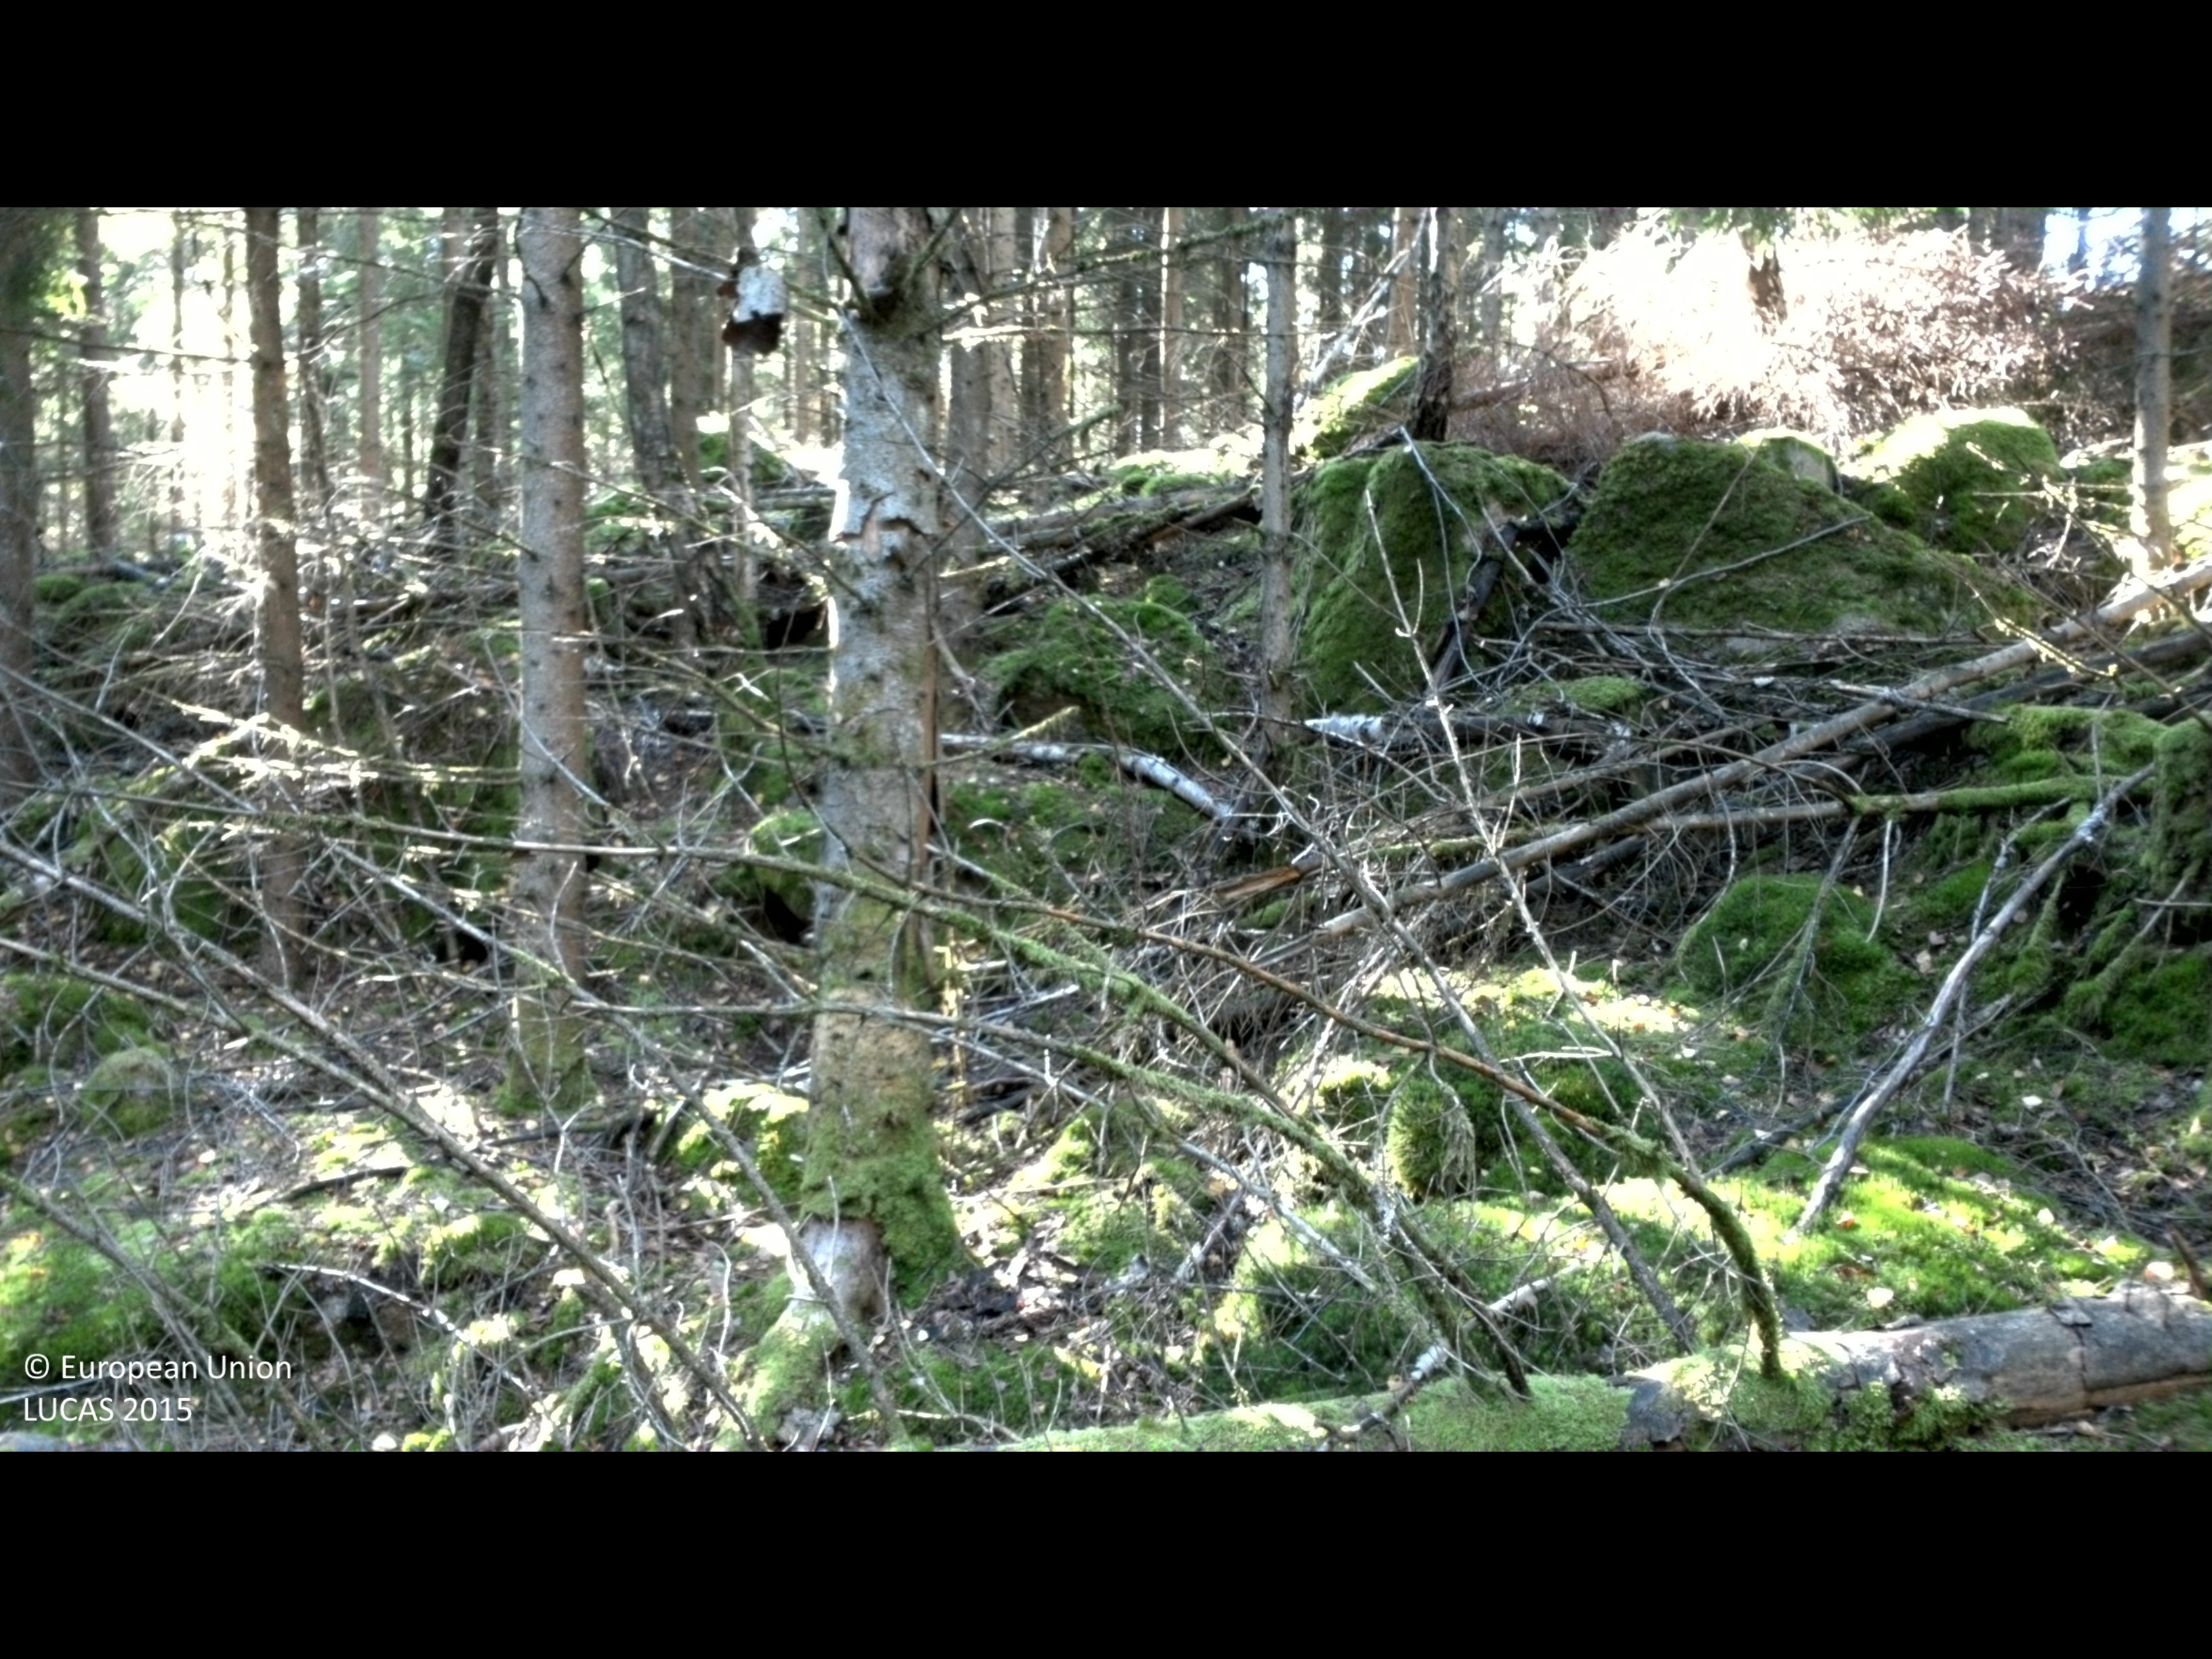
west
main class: Woodland
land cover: Spruce dominated coniferous woodland
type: boreal forest
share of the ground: 50 - 75 %
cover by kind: coniferous forest trees 65 %, lichens and mosses 30 %, broadleaved forest trees 5 %
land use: Forestry
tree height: > 5 m
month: September
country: SE
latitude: 56.1834
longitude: 14.4285
